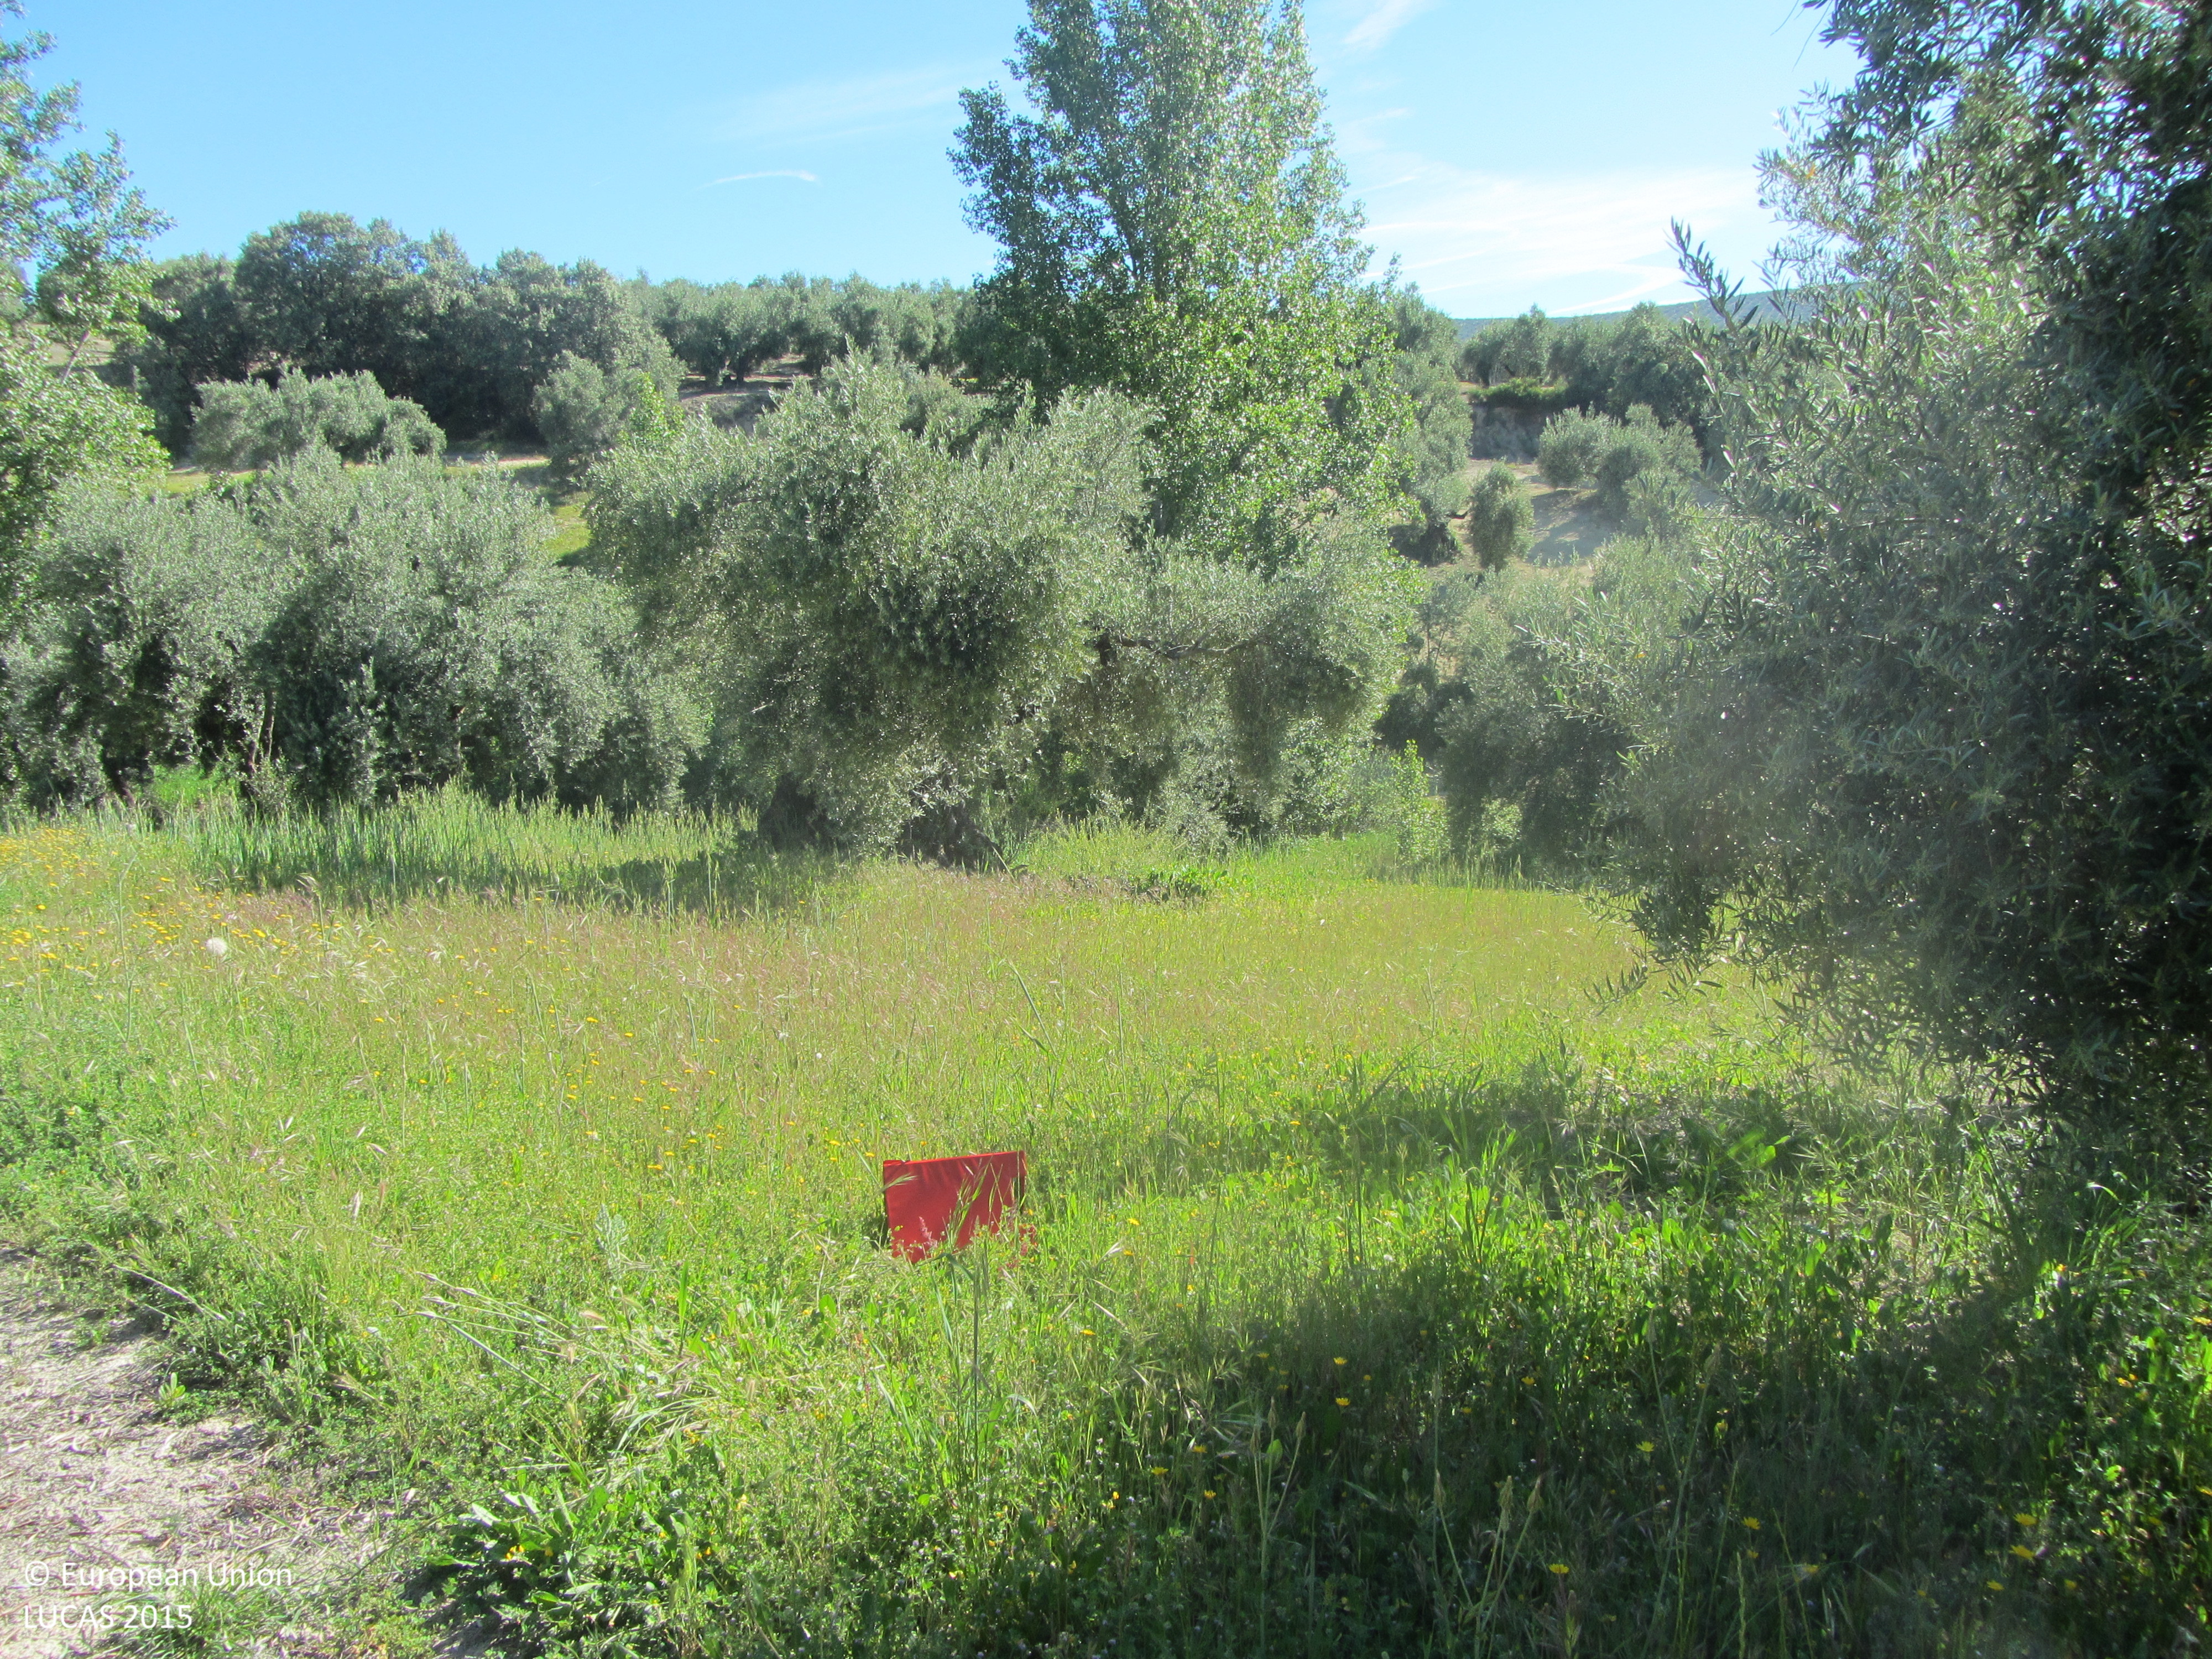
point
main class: Cropland
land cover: Olive groves
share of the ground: 25 - 50 %
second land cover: Spontaneously vegetated surfaces
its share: > 75 %
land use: Agriculture (excluding fallow land and kitchen gardens)
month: May
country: ES
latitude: 38.1116
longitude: -3.0345
